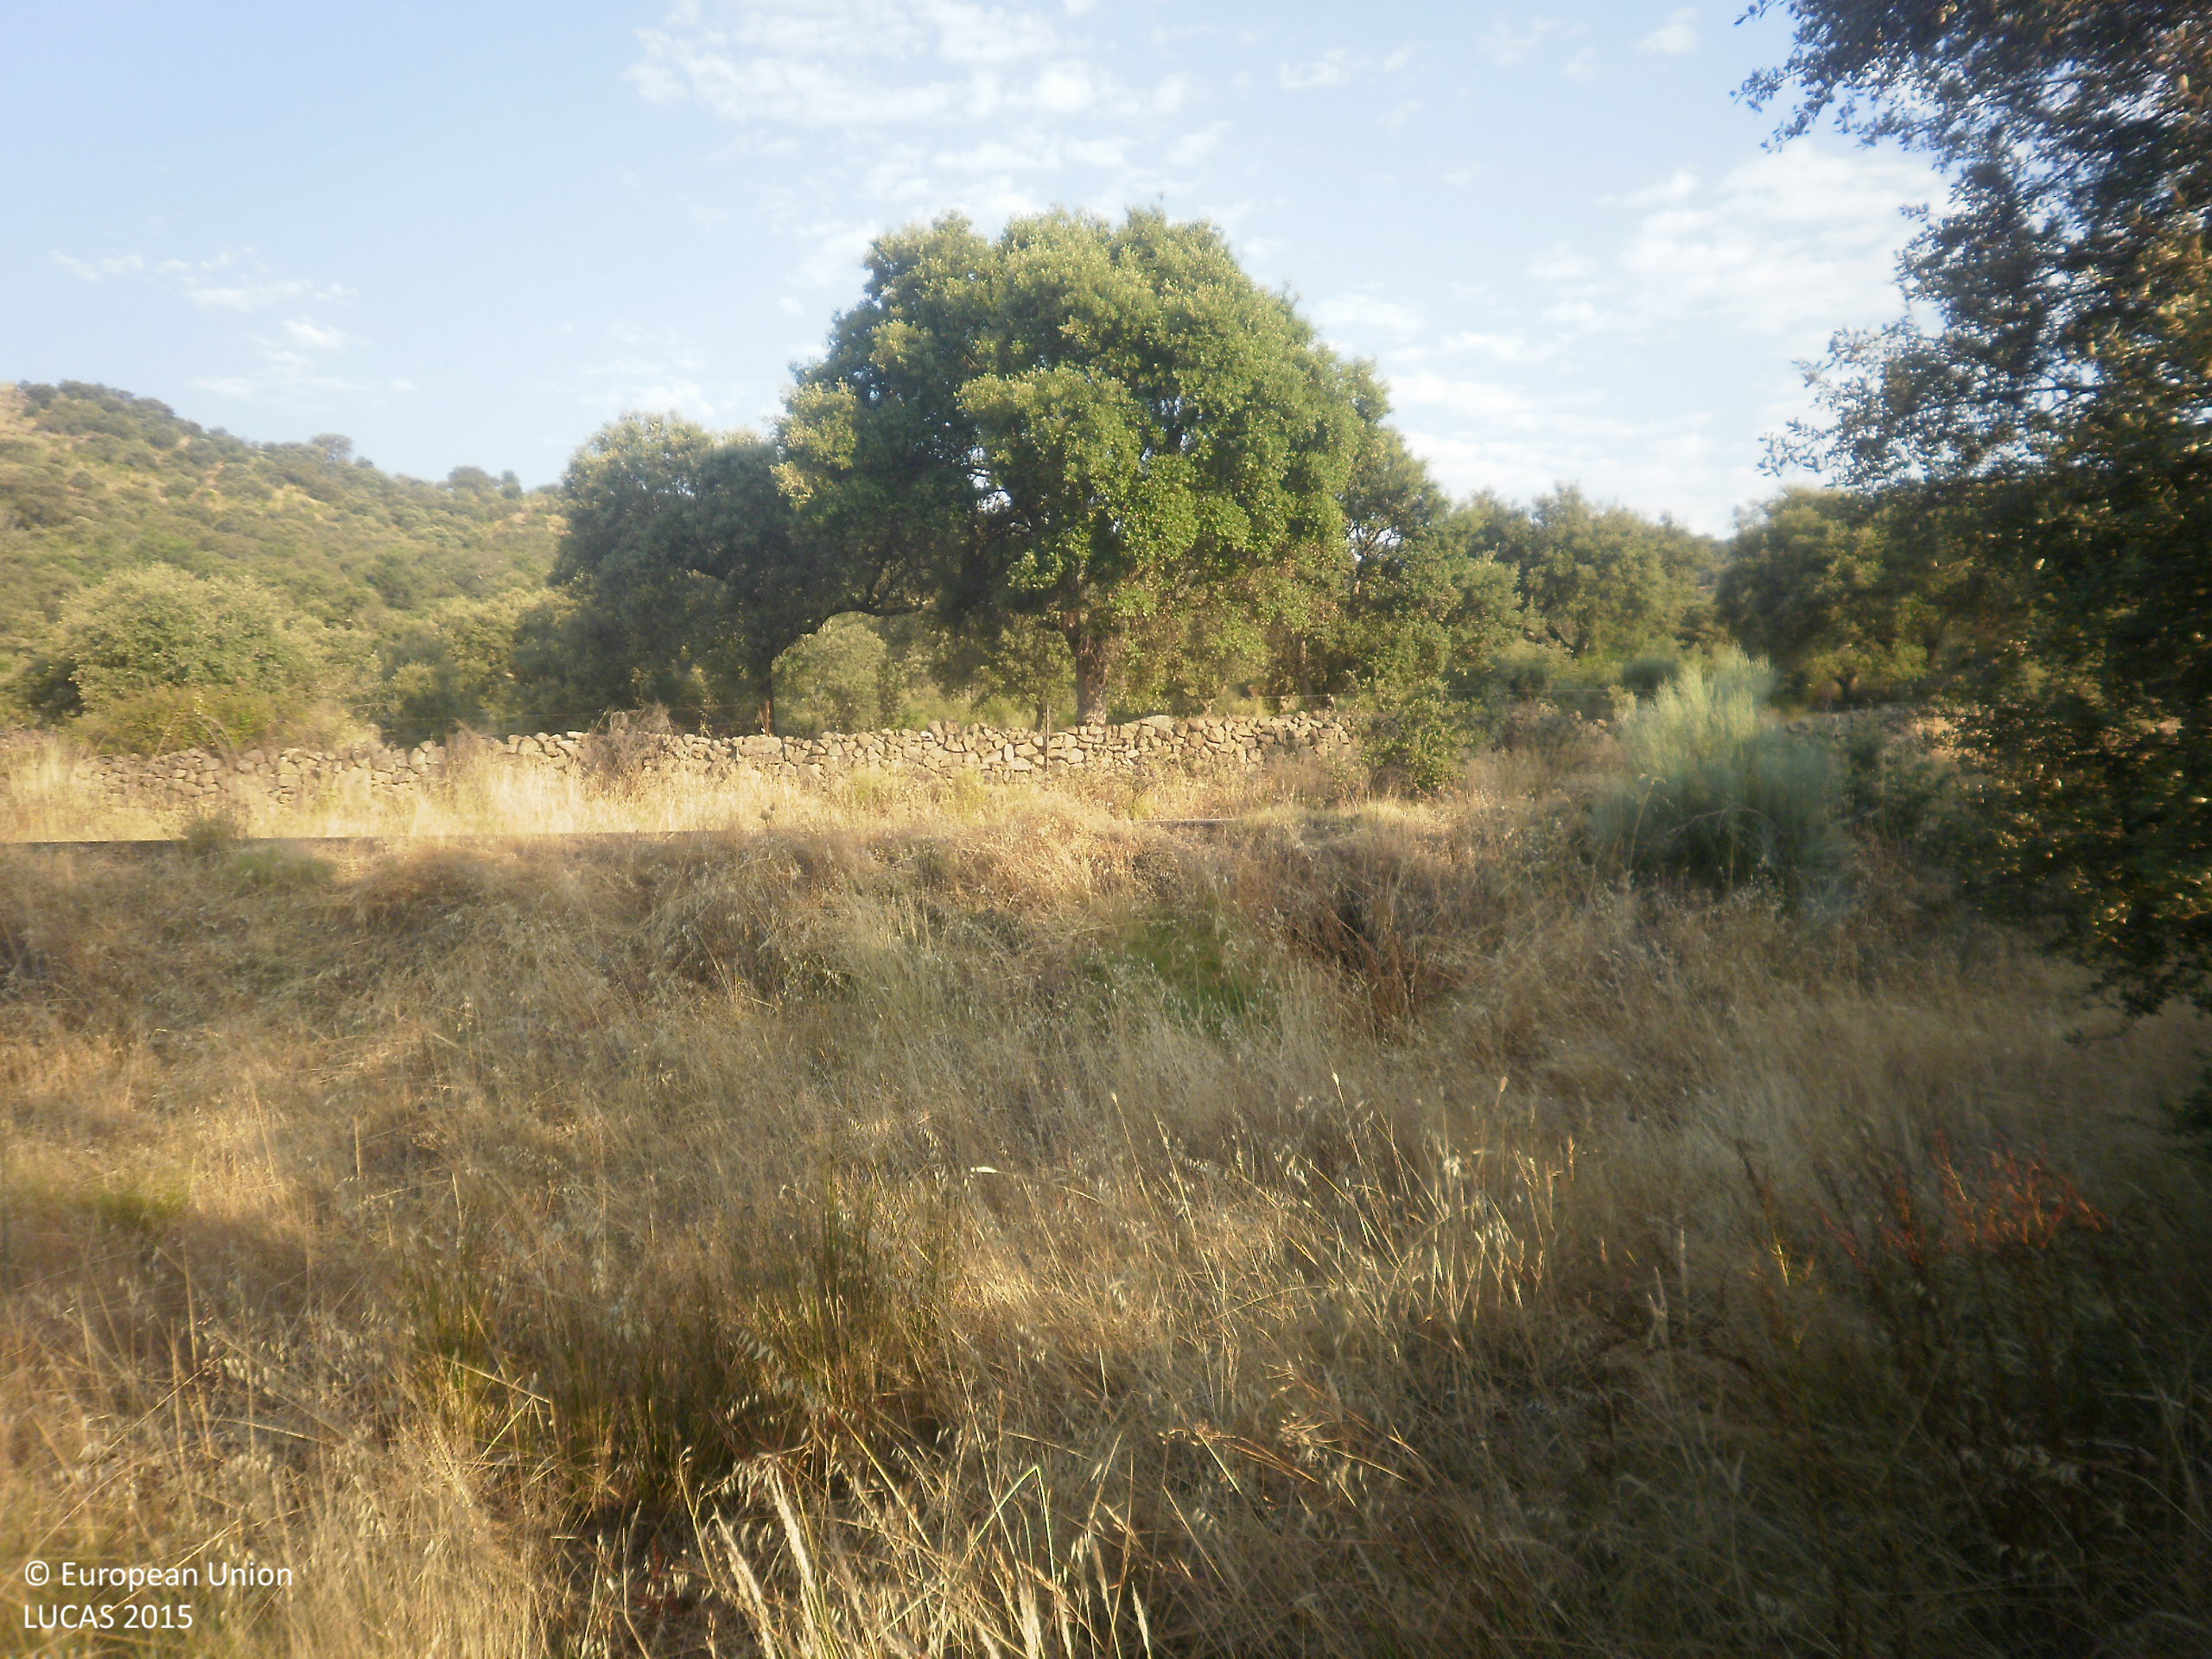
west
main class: Woodland
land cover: Broadleaved woodland
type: broadleaved evergreen forest
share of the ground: 50 - 75 %
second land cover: Grassland without tree/shrub cover
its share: 50 - 75 %
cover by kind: herbaceous plants 70 %, broadleaved forest trees 20 %, shrubs 10 %
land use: Forestry
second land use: Agriculture (excluding fallow land and kitchen gardens)
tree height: > 5 m
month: June
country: ES
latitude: 39.2665
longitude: -5.9464
